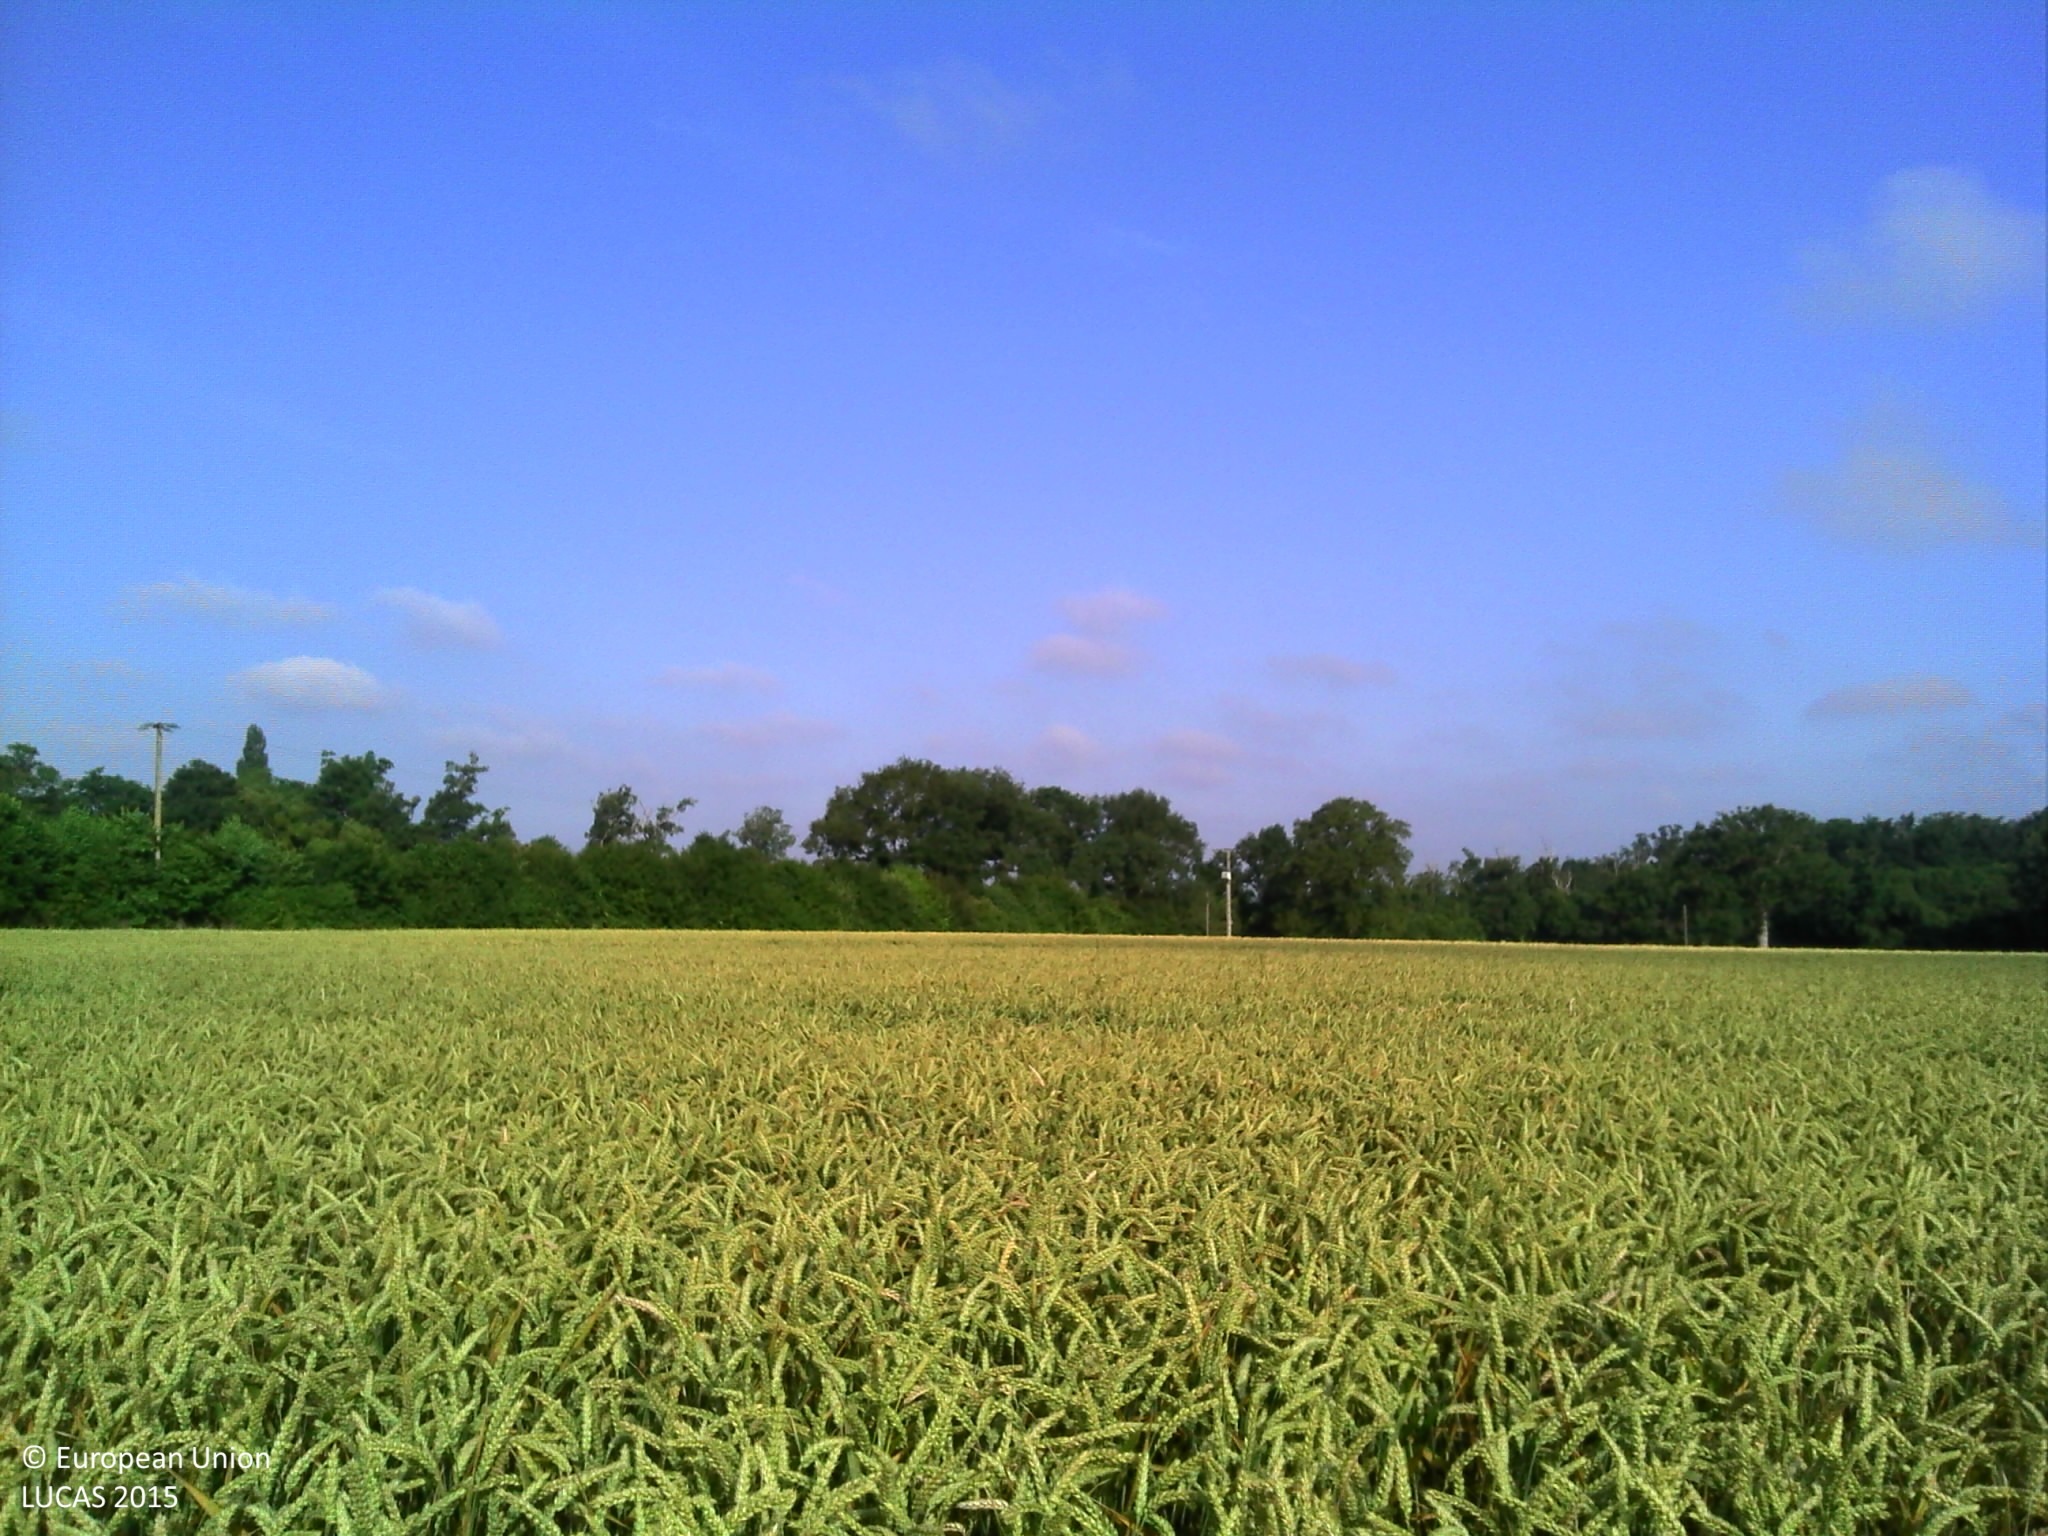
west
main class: Cropland
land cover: Common wheat
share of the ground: > 75 %
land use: Agriculture (excluding fallow land and kitchen gardens)
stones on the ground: < 10 %
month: June
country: FR
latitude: 48.2020
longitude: 0.1914
